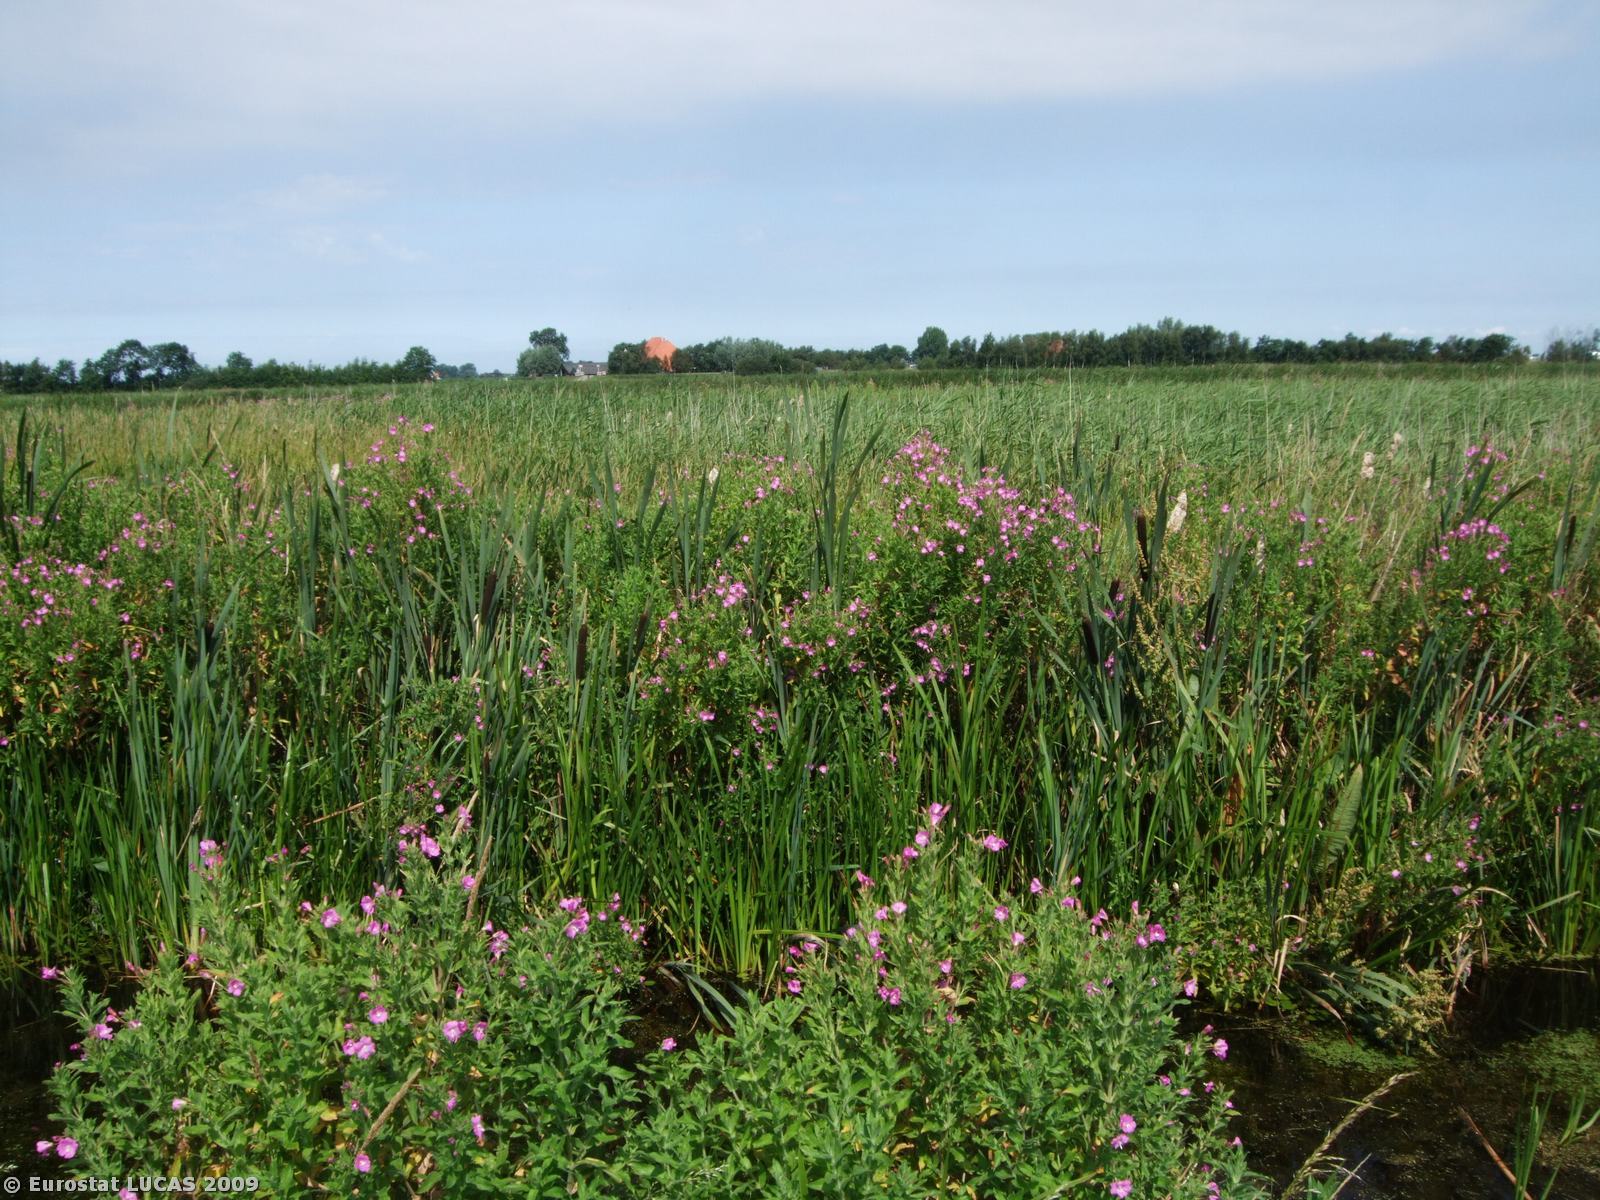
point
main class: Wetlands
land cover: Inland marshes
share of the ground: > 75 %
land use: Unused
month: May
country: NL
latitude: 53.0172
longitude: 5.6313
